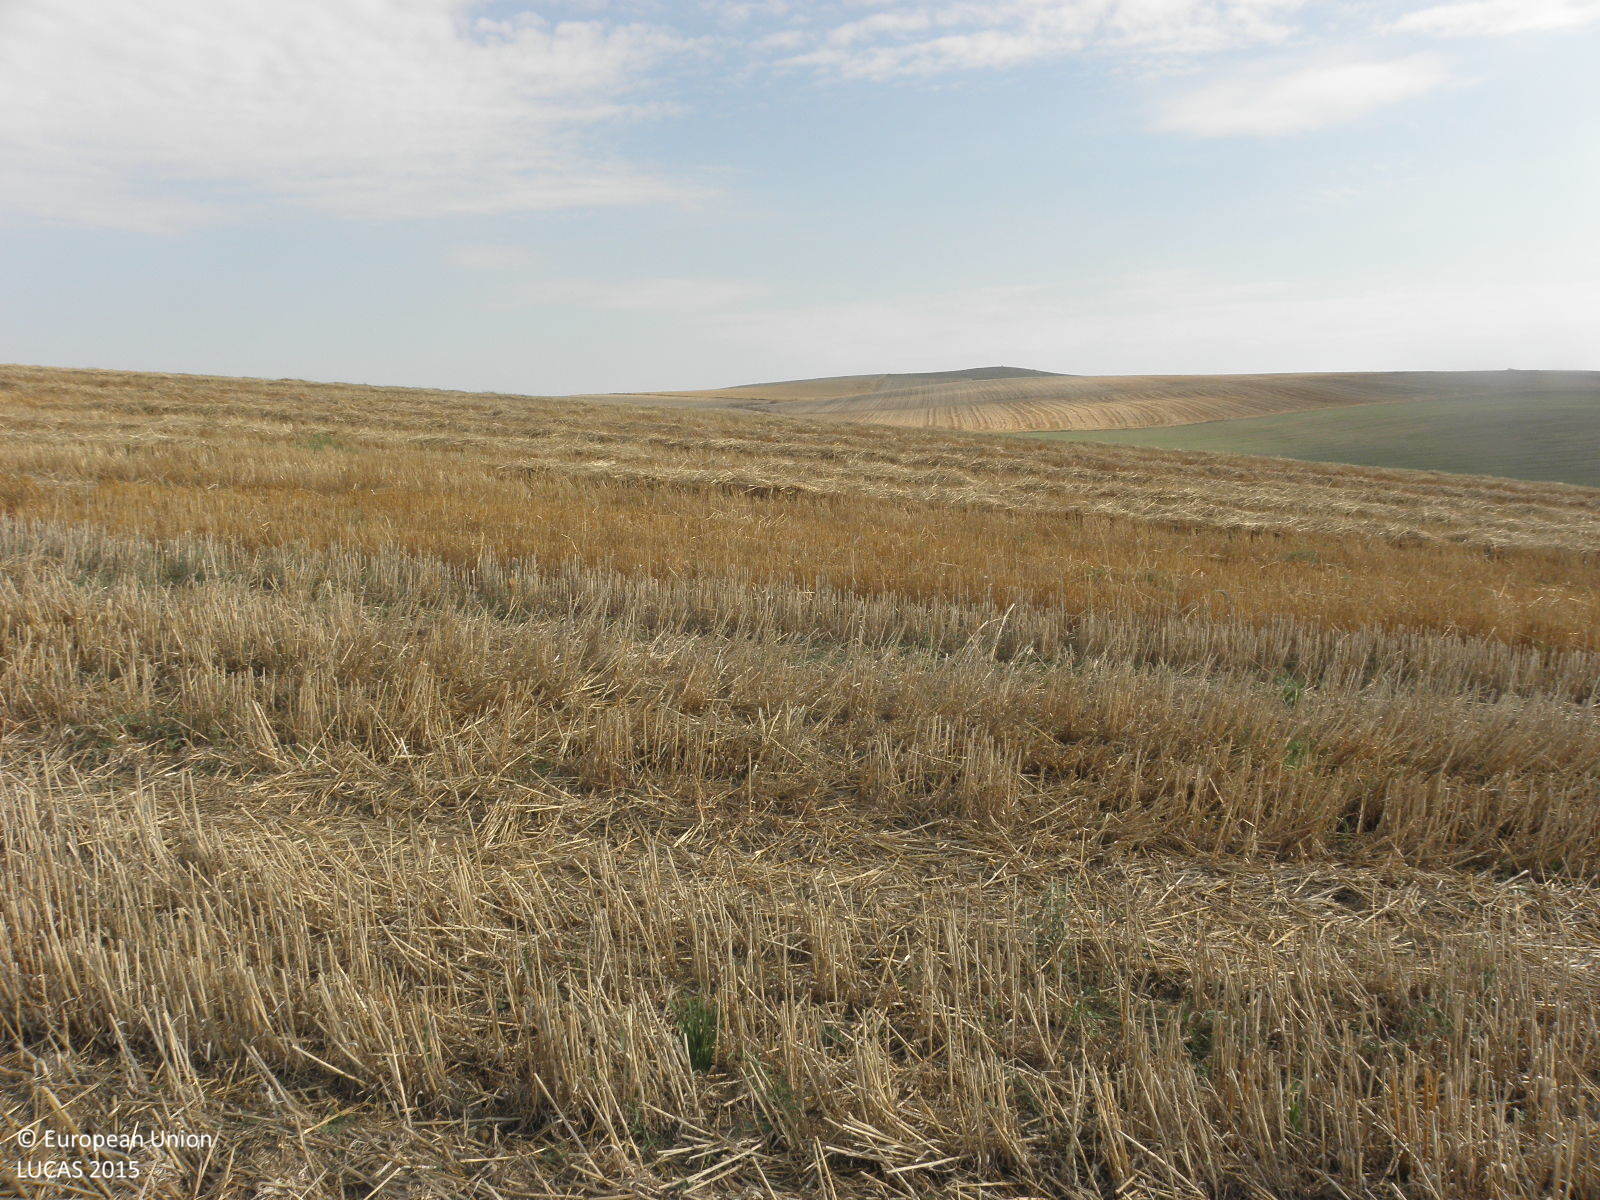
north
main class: Cropland
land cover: Durum wheat
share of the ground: > 75 %
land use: Agriculture (excluding fallow land and kitchen gardens)
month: July
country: GR
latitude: 39.3596
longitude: 22.4628
